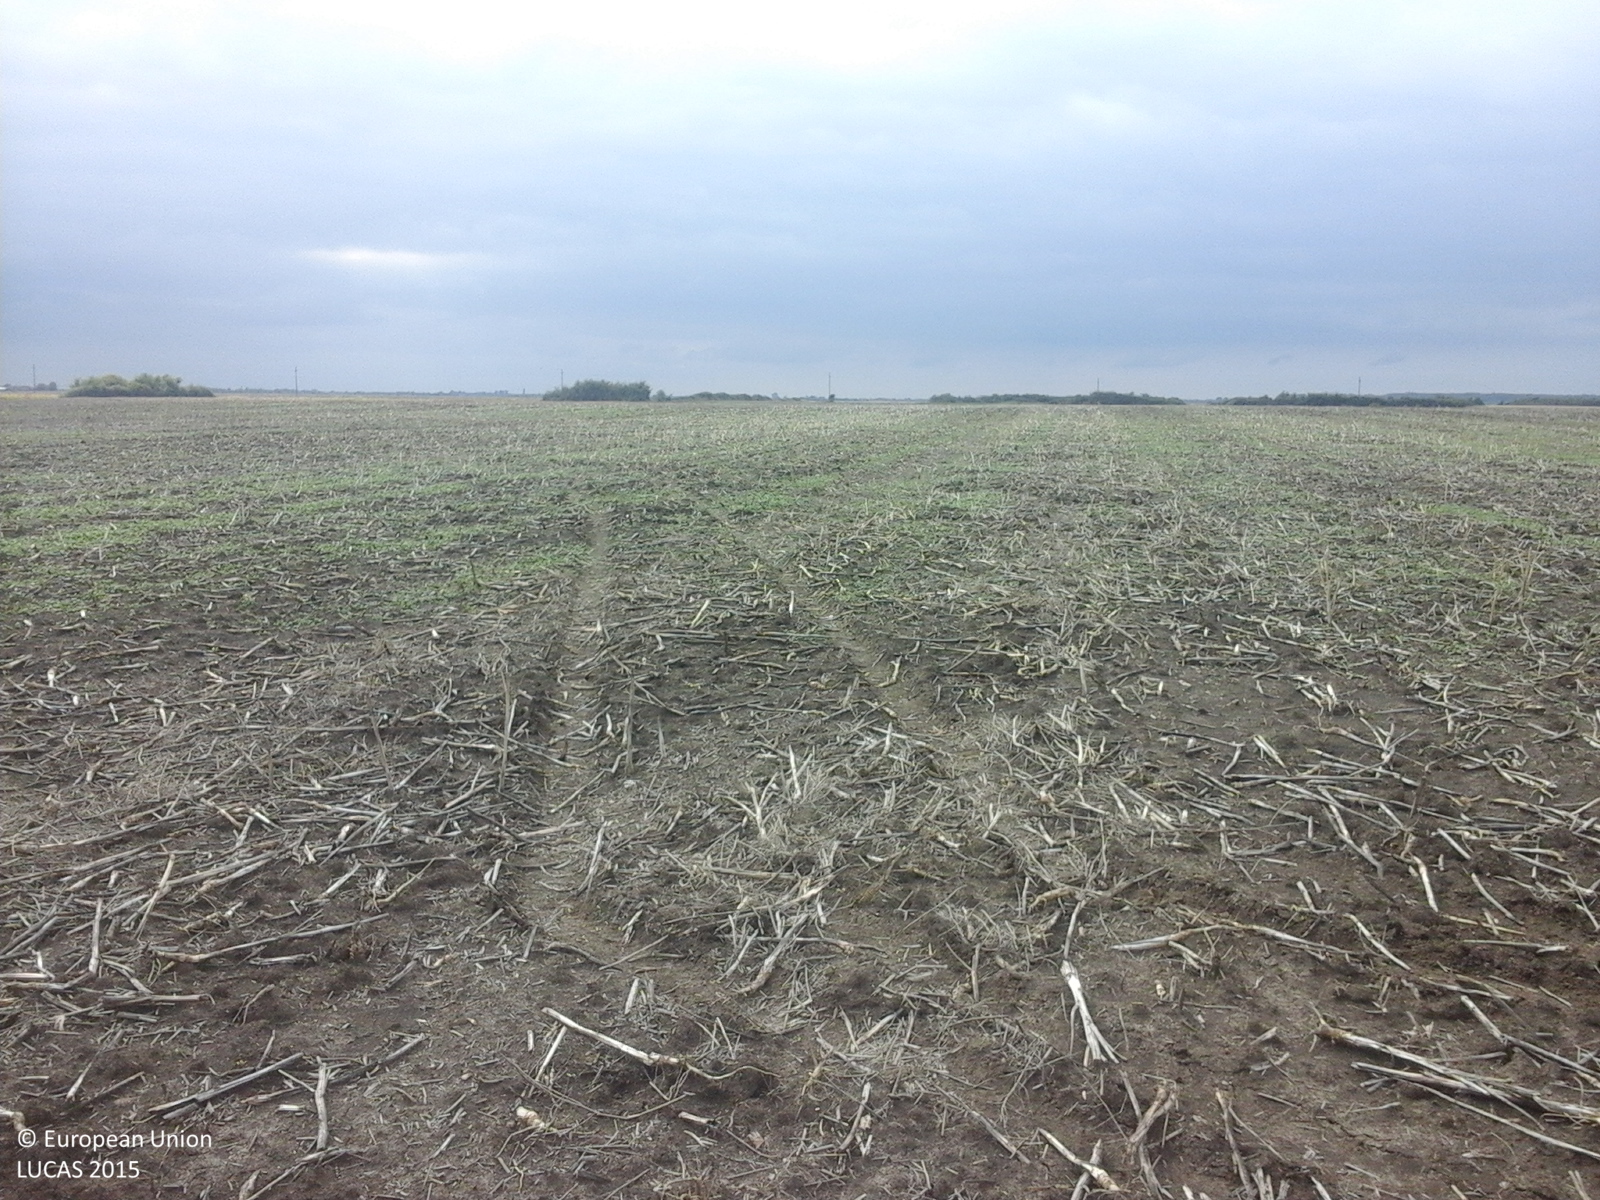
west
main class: Cropland
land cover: Rape and turnip rape
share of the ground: < 10 %
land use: Agriculture (excluding fallow land and kitchen gardens)
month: August
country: RO
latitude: 45.4663
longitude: 21.0649
